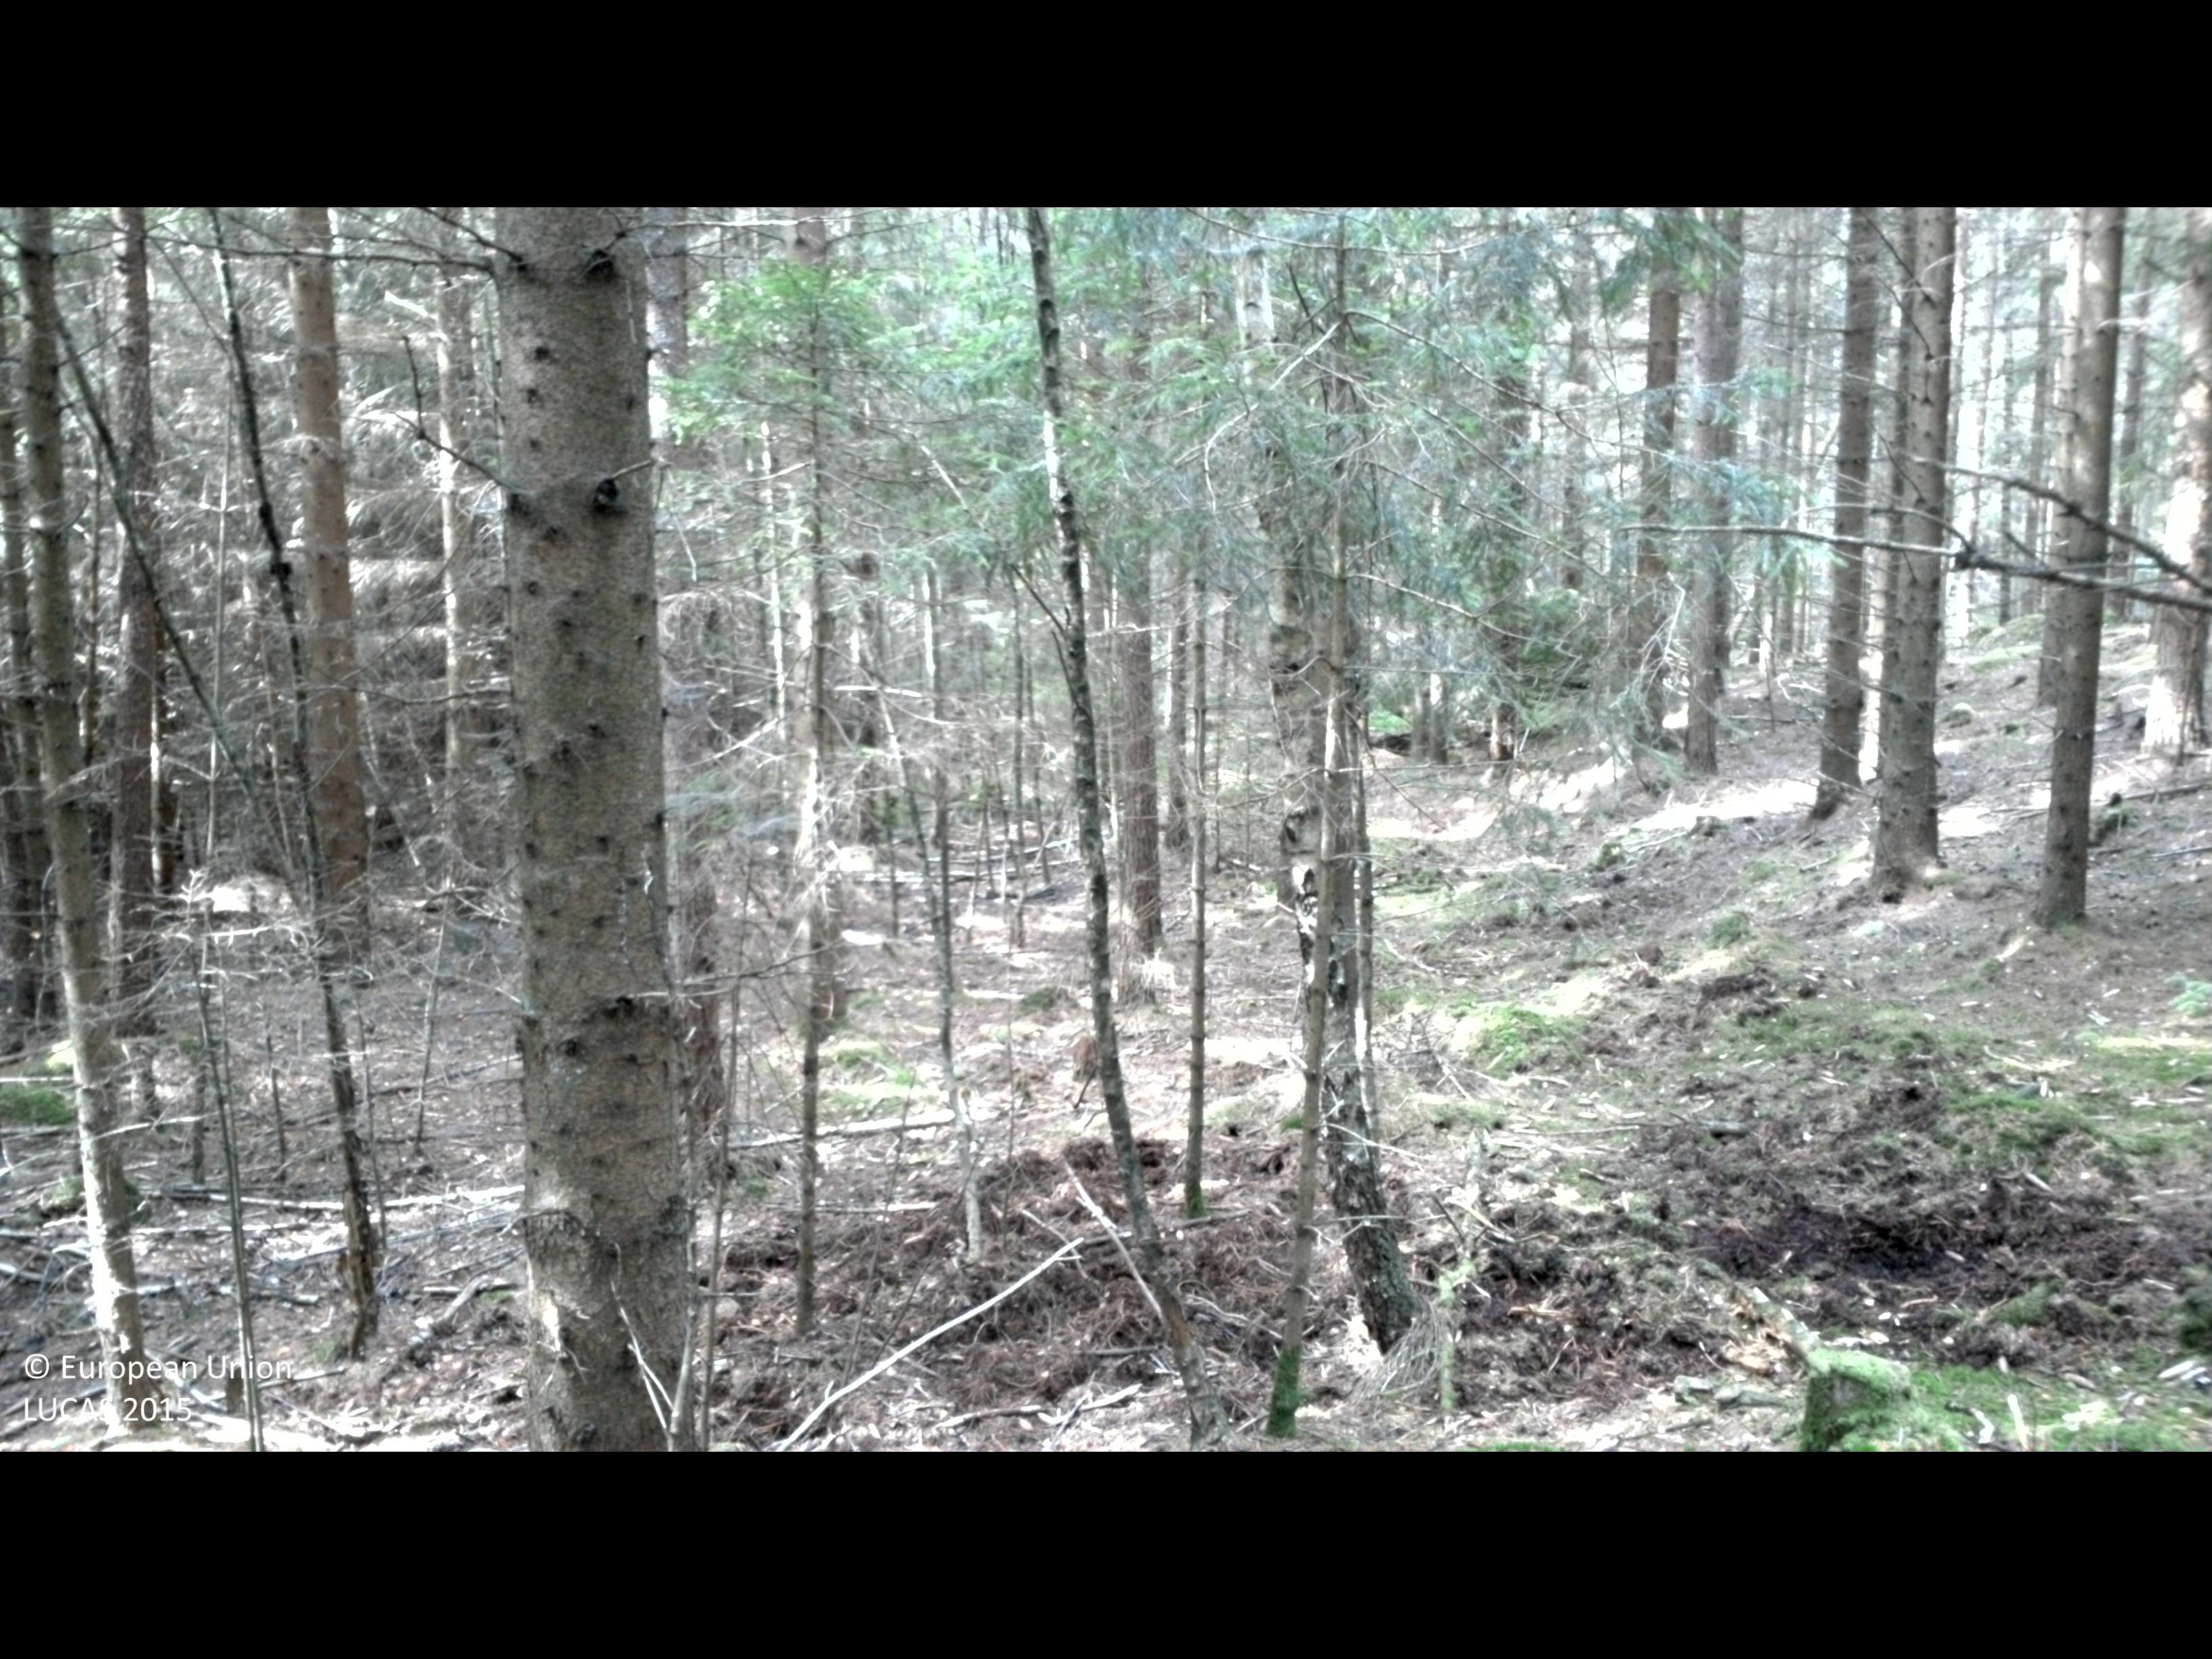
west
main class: Woodland
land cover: Spruce dominated coniferous woodland
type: boreal forest
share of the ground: > 75 %
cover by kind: coniferous forest trees 75 %, lichens and mosses 20 %
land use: Forestry
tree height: > 5 m
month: August
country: SE
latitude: 56.3112
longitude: 14.3784
